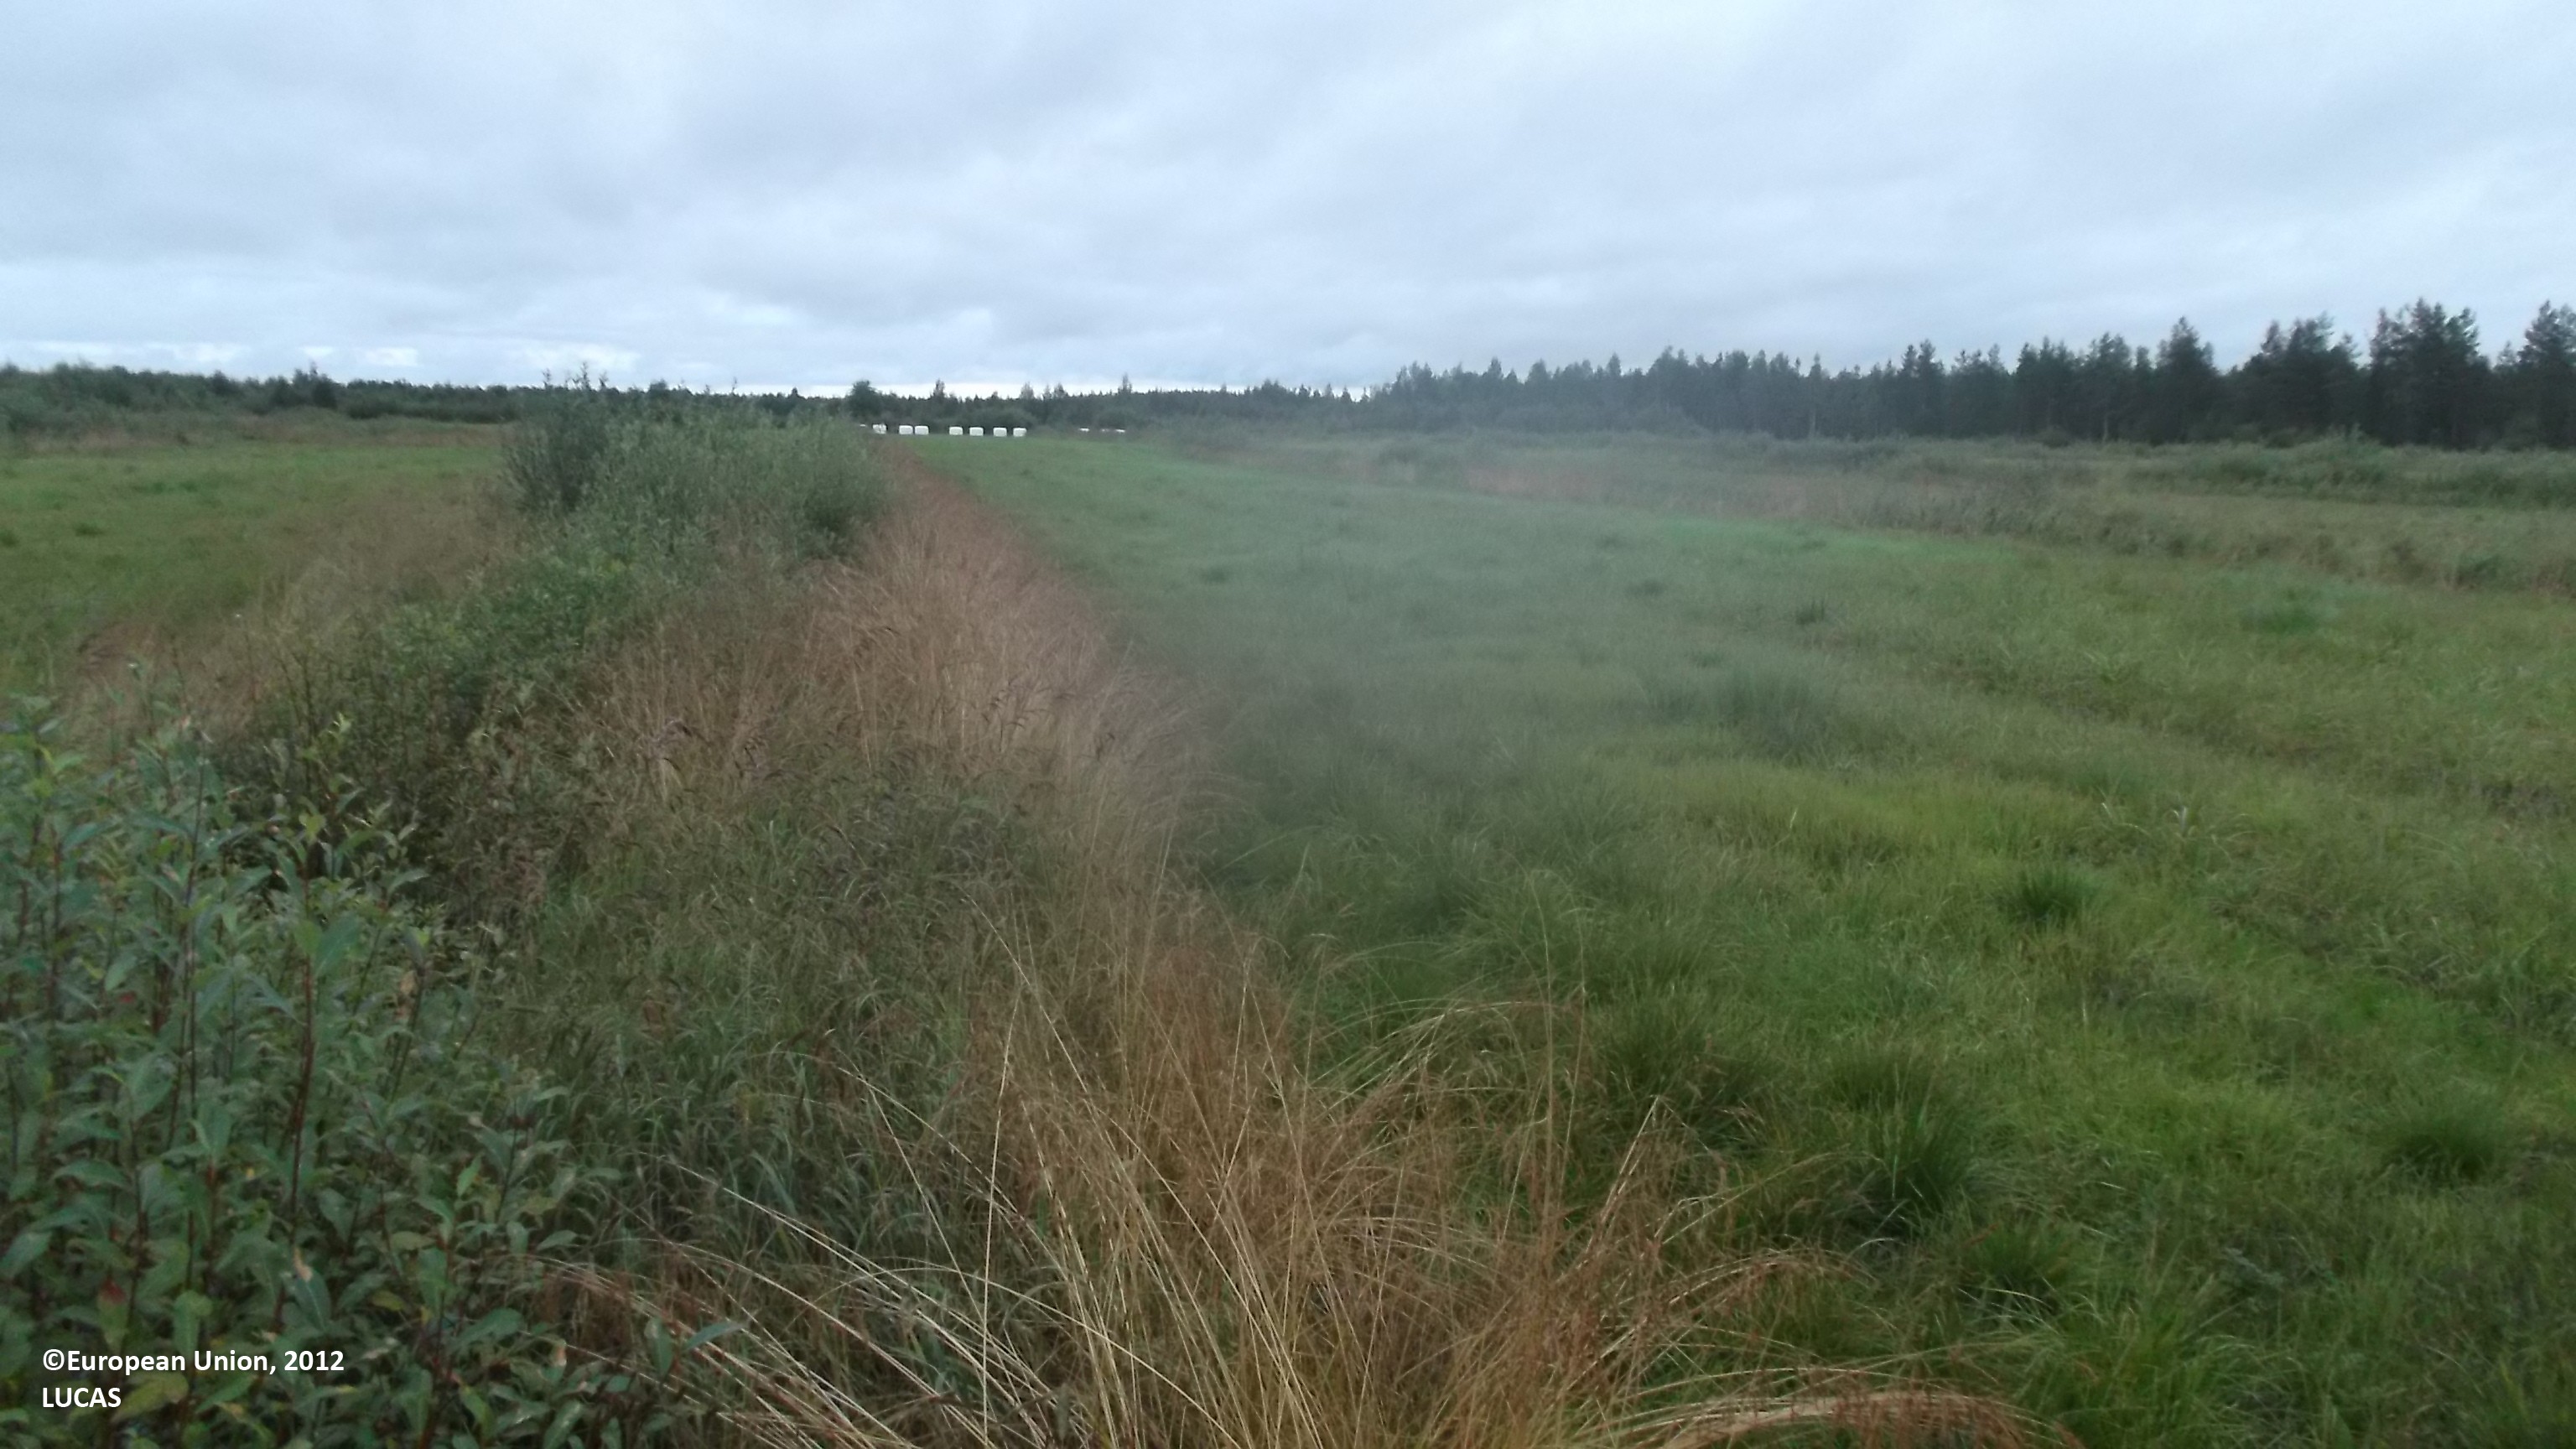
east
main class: Cropland
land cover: Temporary grasslands
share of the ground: > 75 %
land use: Agriculture (excluding fallow land and kitchen gardens)
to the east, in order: Temporary grasslands; Ditches and canals; Abandoned hedges; Temporary grasslands; Ditches and canals; Temporary grasslands; Ditches and canals; Abandoned hedges; Temporary grasslands; Ditches and canals; Temporary grasslands; Ditches and canals; Temporary grasslands; Ditches and canals; Grassland without tree/shrub cover
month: August
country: FI
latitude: 63.2328
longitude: 24.4714
